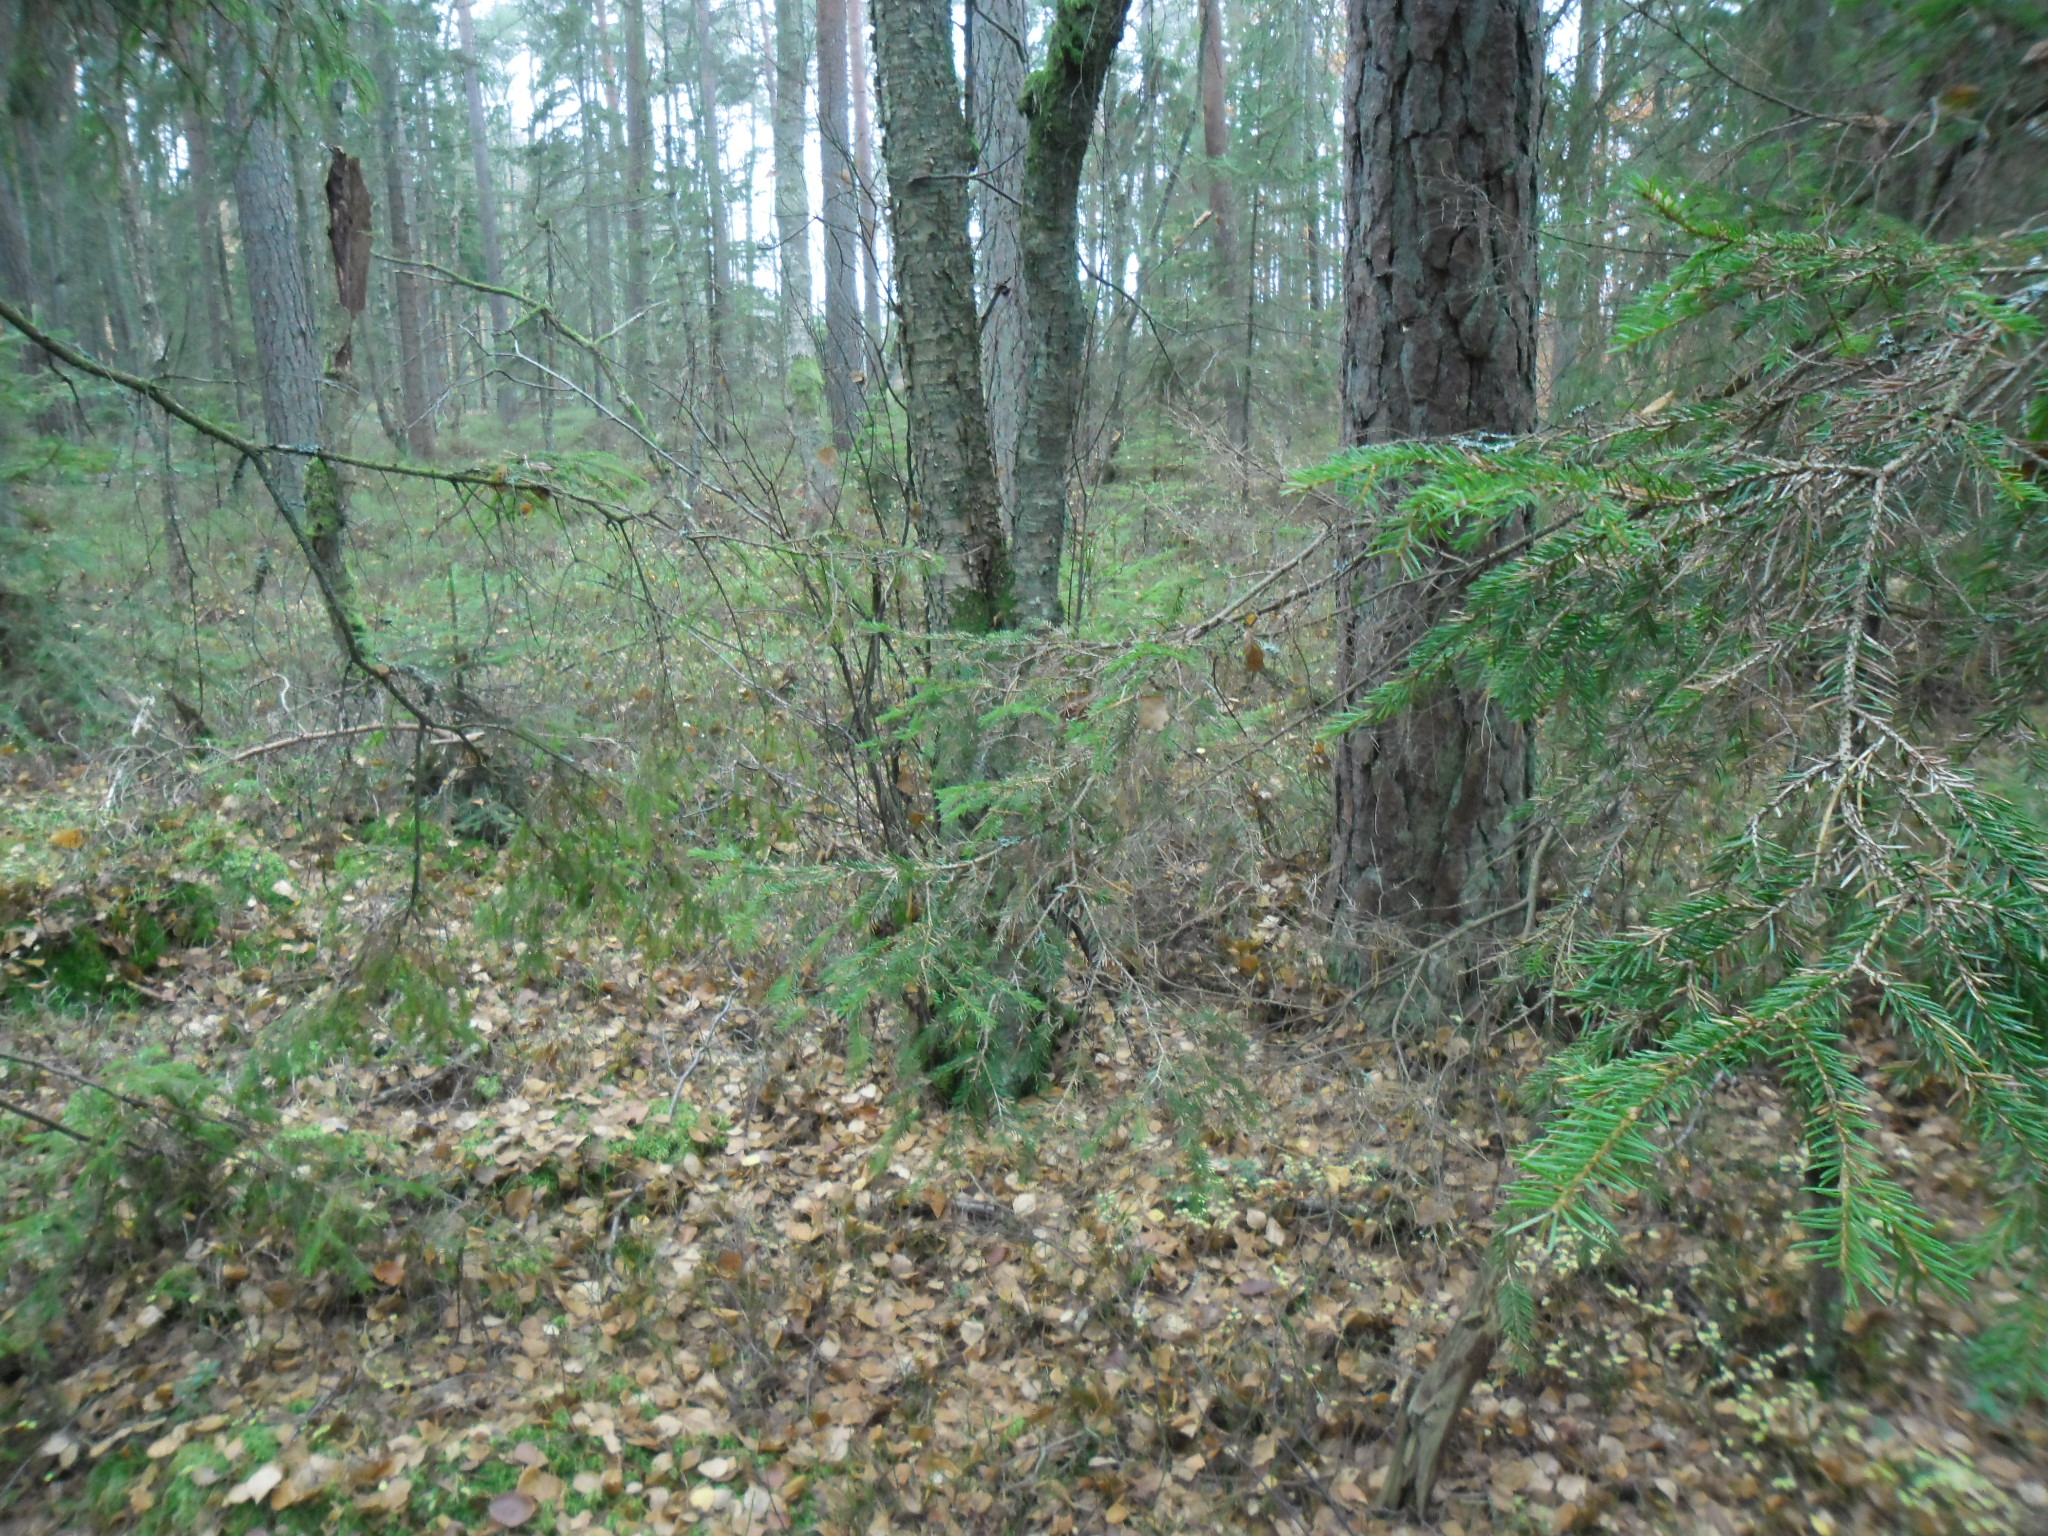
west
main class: Woodland
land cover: Pine dominated mixed woodland
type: boreal forest
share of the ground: > 75 %
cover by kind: coniferous forest trees 60 %, broadleaved forest trees 20 %, shrubs 20 %
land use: Forestry
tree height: > 5 m
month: November
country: SE
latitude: 56.3126
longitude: 13.0849
